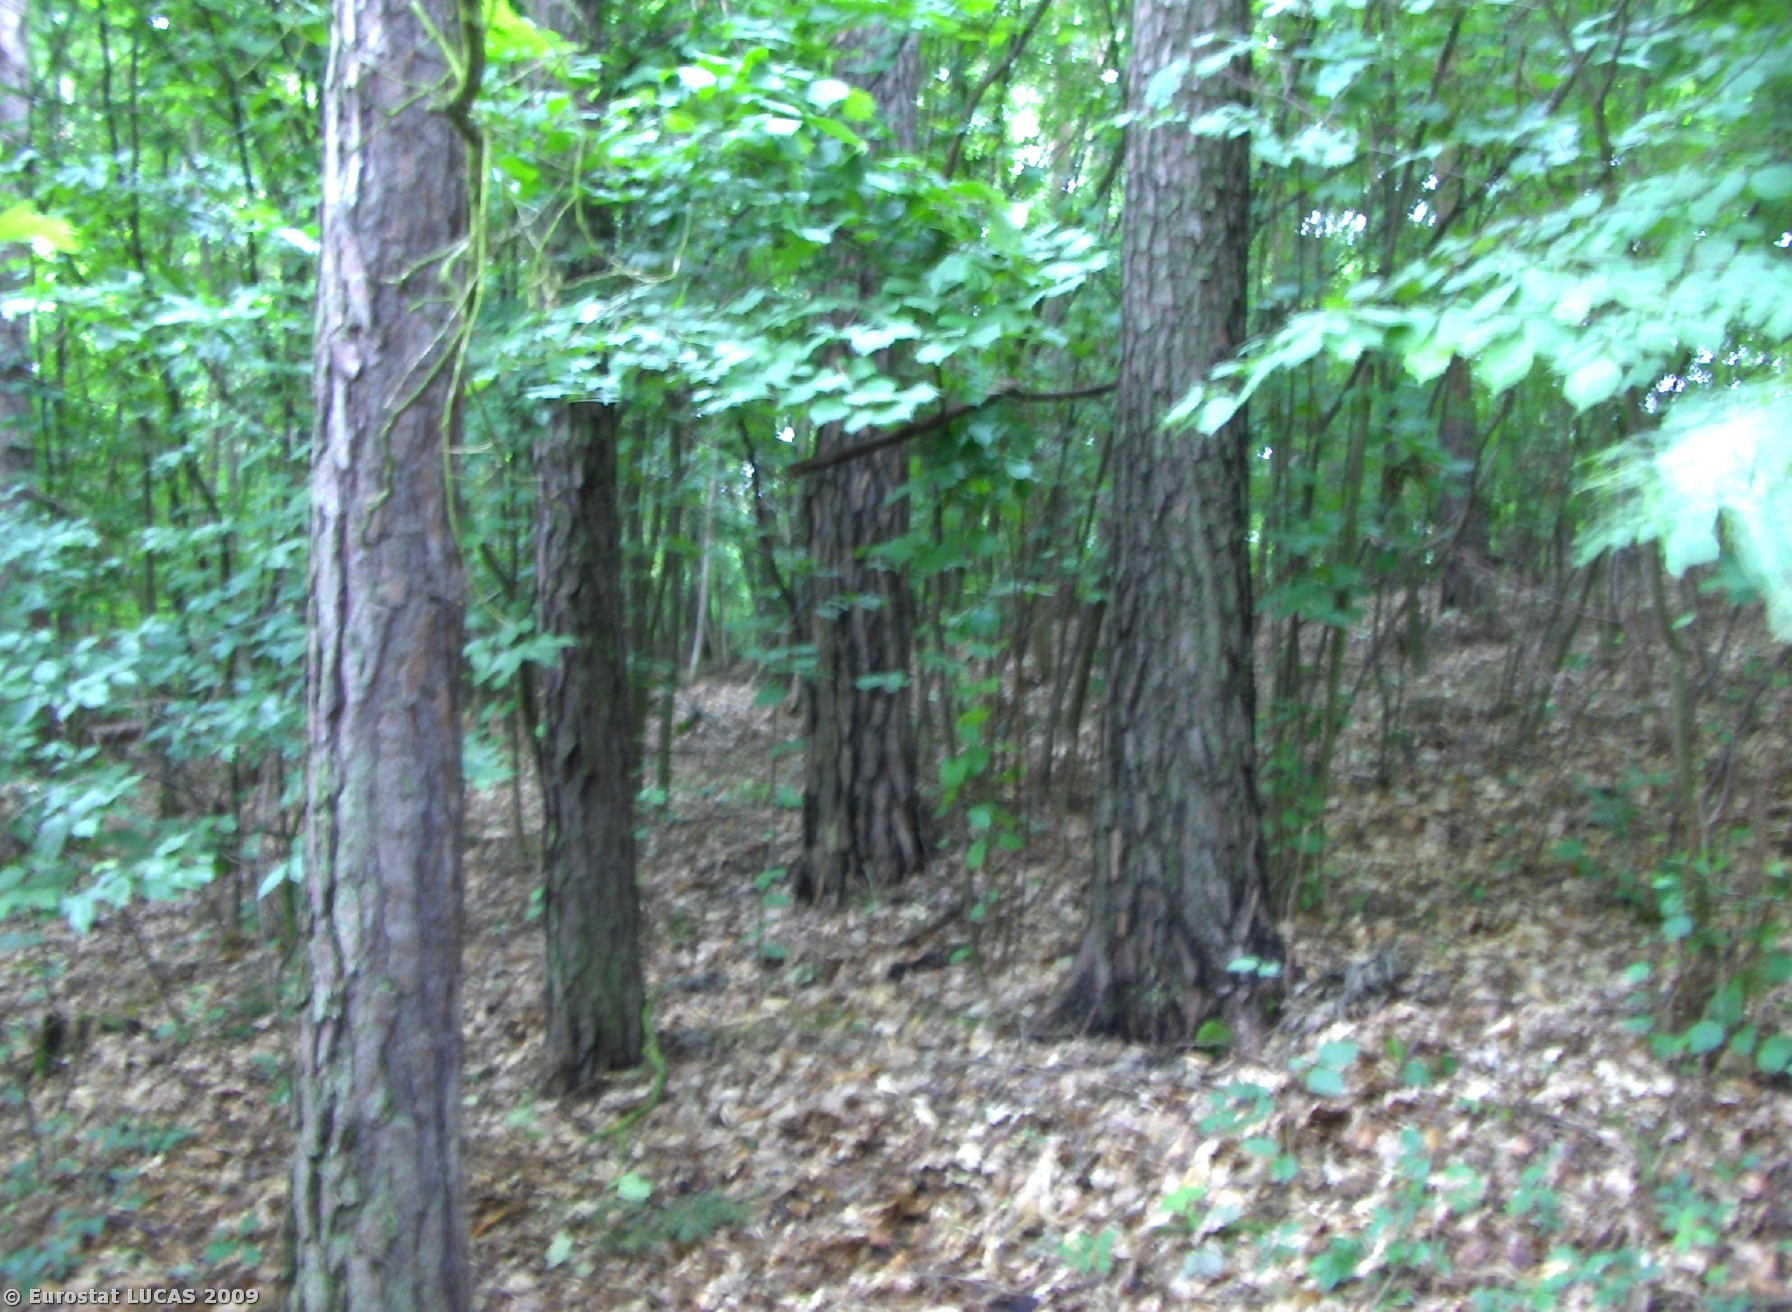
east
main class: Woodland
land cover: Mixed woodland
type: hemiboreal forest and nemoral coniferous forest and mixed broadleaved-coniferous forest
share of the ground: > 75 %
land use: Nature reserves
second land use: Forestry
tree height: > 5 m
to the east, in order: Mixed woodland; Maize; Grass margins; Paved roads, cycling and walking lanes; Grass margins; Maize; Mixed woodland; Tracks; Coniferous woodland
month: June
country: CZ
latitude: 49.7223
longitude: 14.3707
